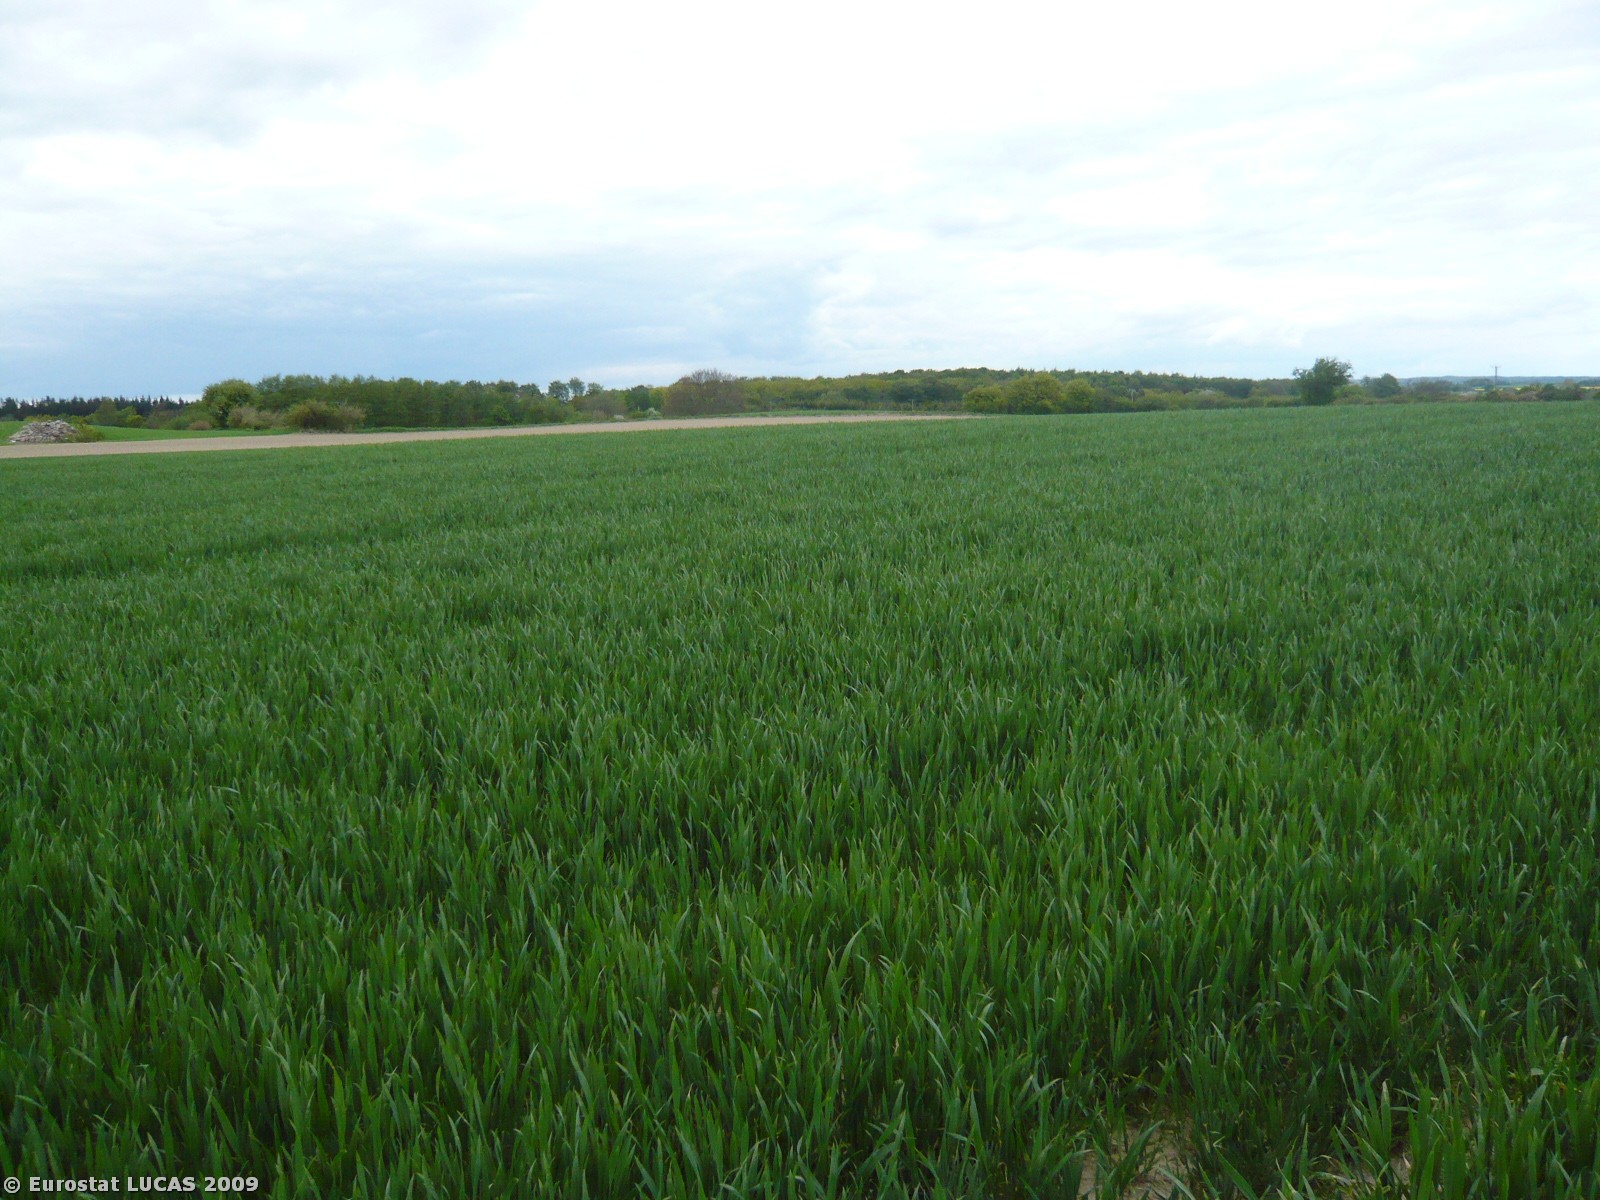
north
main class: Cropland
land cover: Common wheat
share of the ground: > 75 %
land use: Agriculture (excluding fallow land and kitchen gardens)
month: May
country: DK
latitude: 55.1125
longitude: 11.9269
